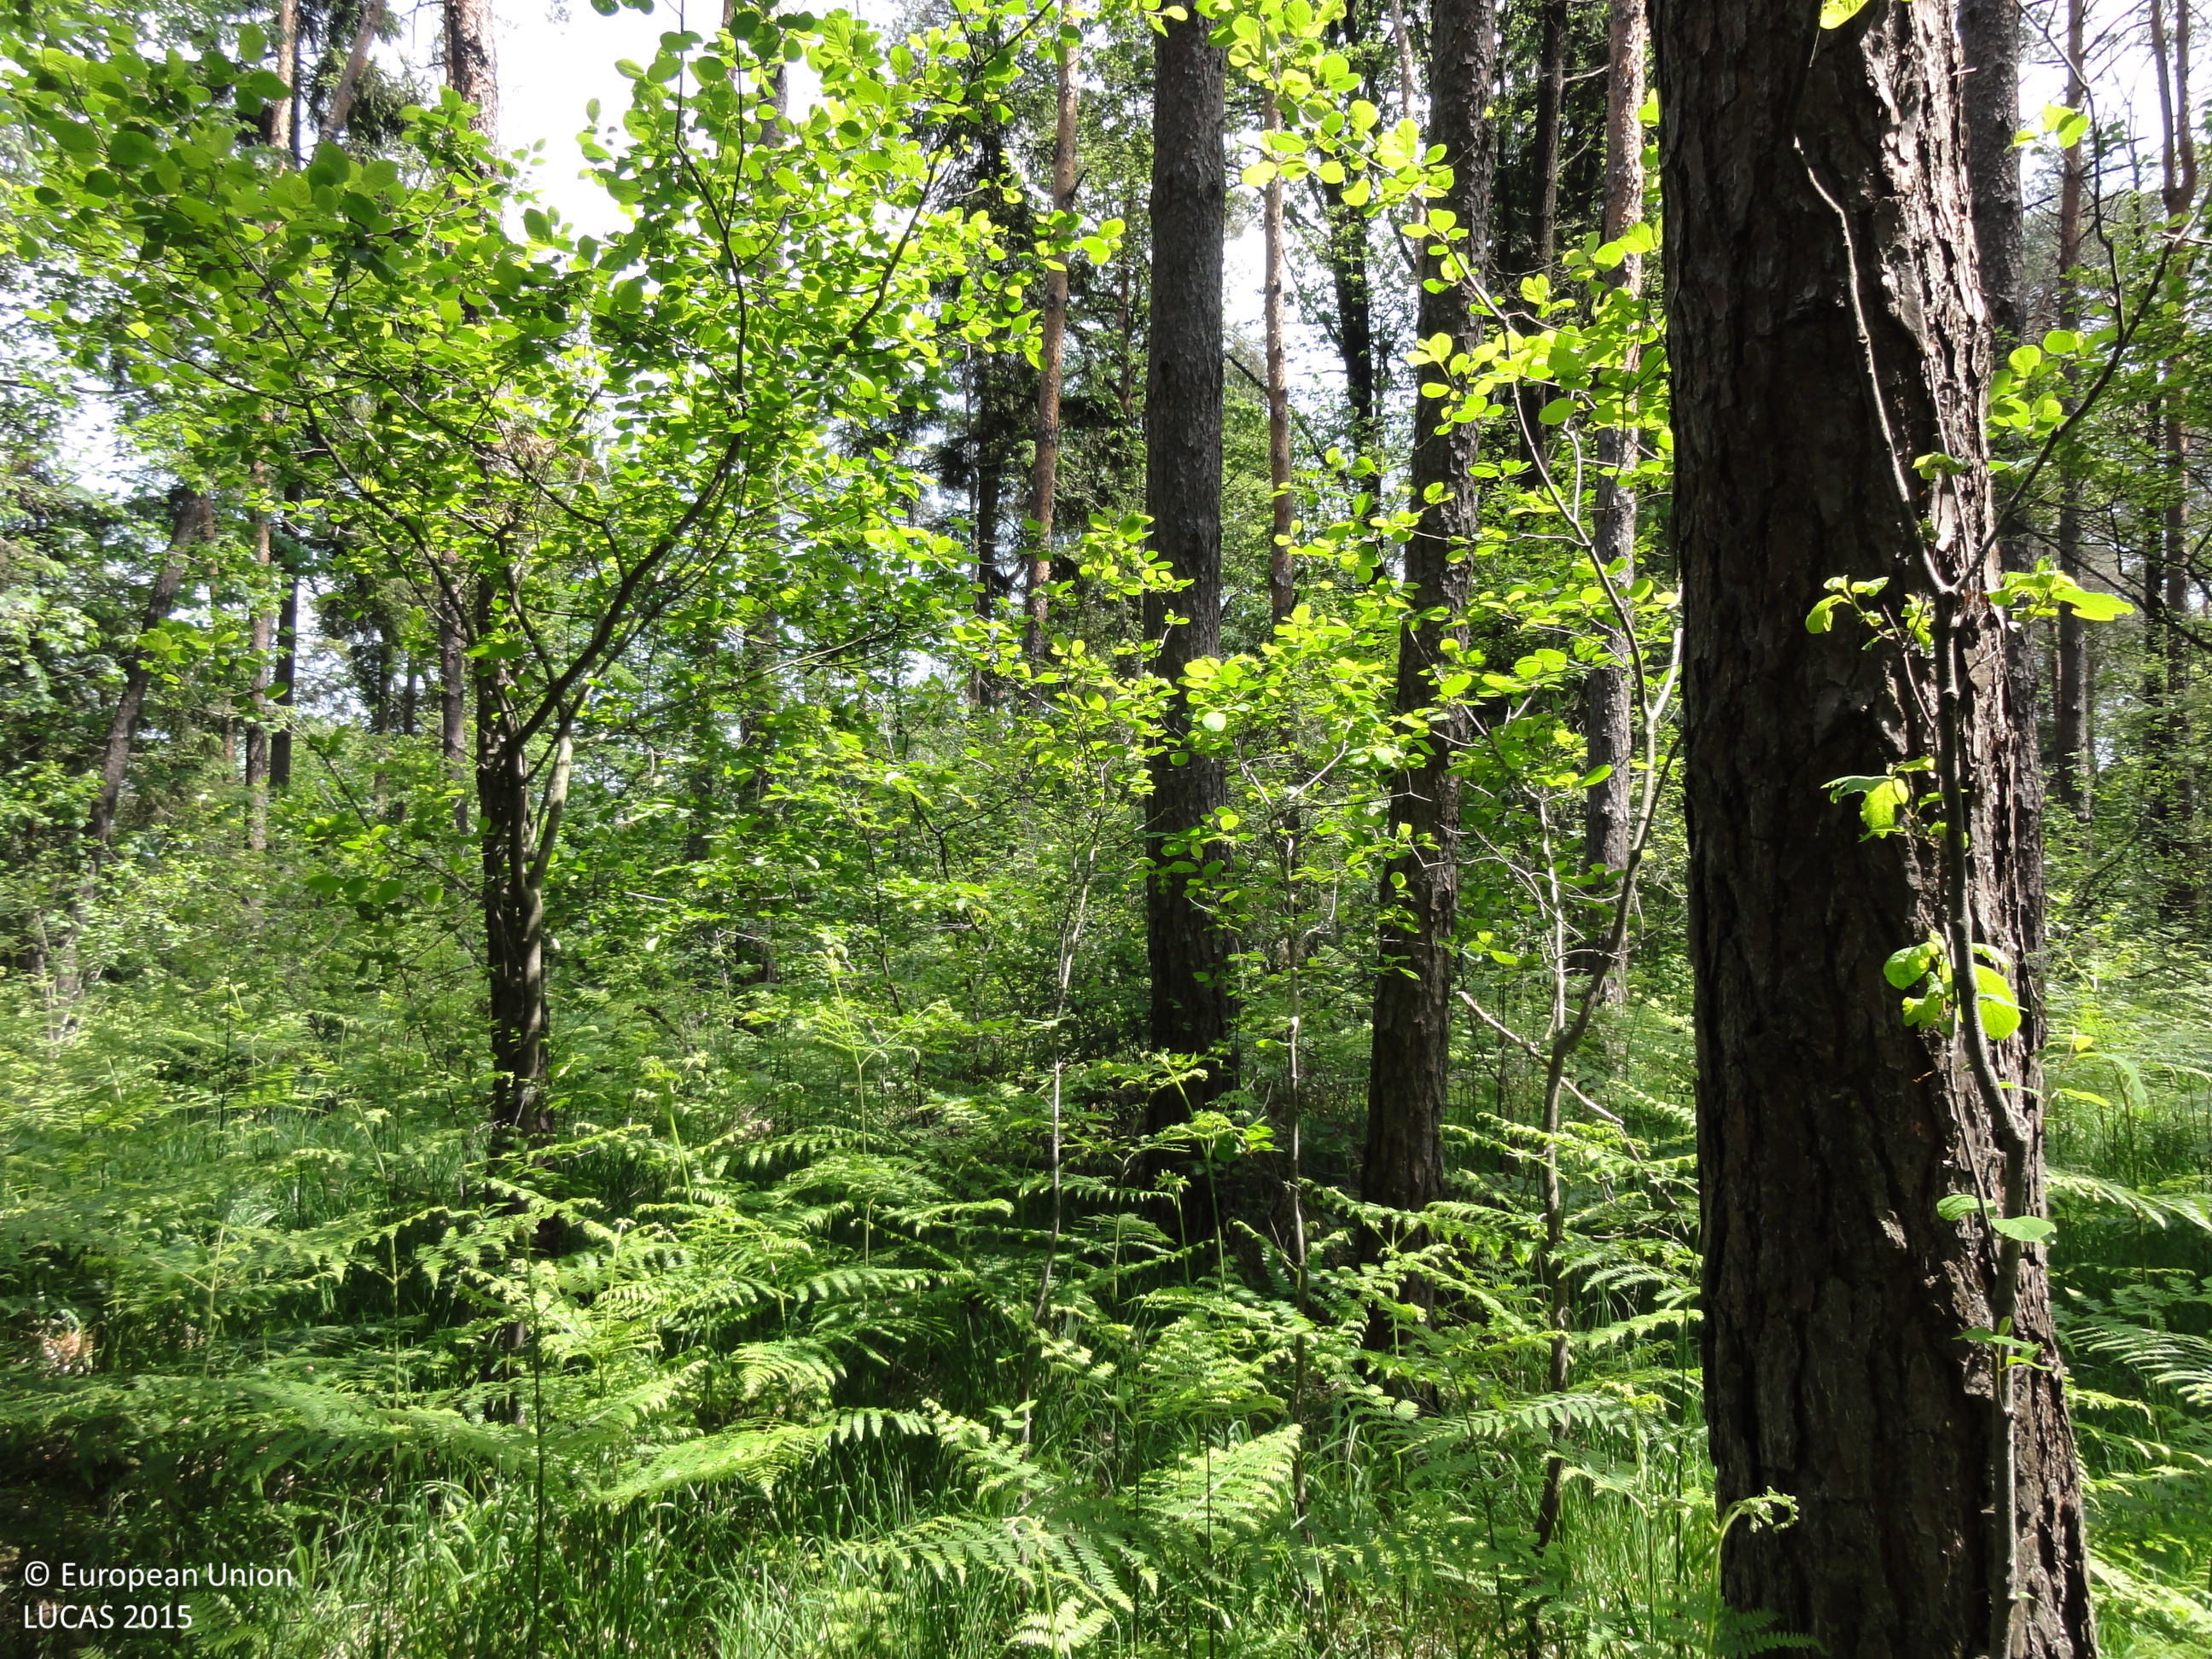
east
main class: Woodland
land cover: Pine dominated mixed woodland
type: mesophytic deciduous forest
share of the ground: > 75 %
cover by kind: coniferous forest trees 55 %, broadleaved forest trees 40 %, shrubs 5 %
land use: Forestry
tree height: > 5 m
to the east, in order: Pine dominated mixed woodland; Ditches and canals; Pine dominated mixed woodland; Spruce dominated mixed woodland; Tracks; Broadleaved woodland; Shrubland with sparse tree cover; Inland marshes; Electric lines; Grassland without tree/shrub cover; Paved roads, cycling and walking lanes; Grass margins; Ditches and canals; Broadleaved woodland
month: May
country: SI
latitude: 46.2763
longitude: 15.2535
